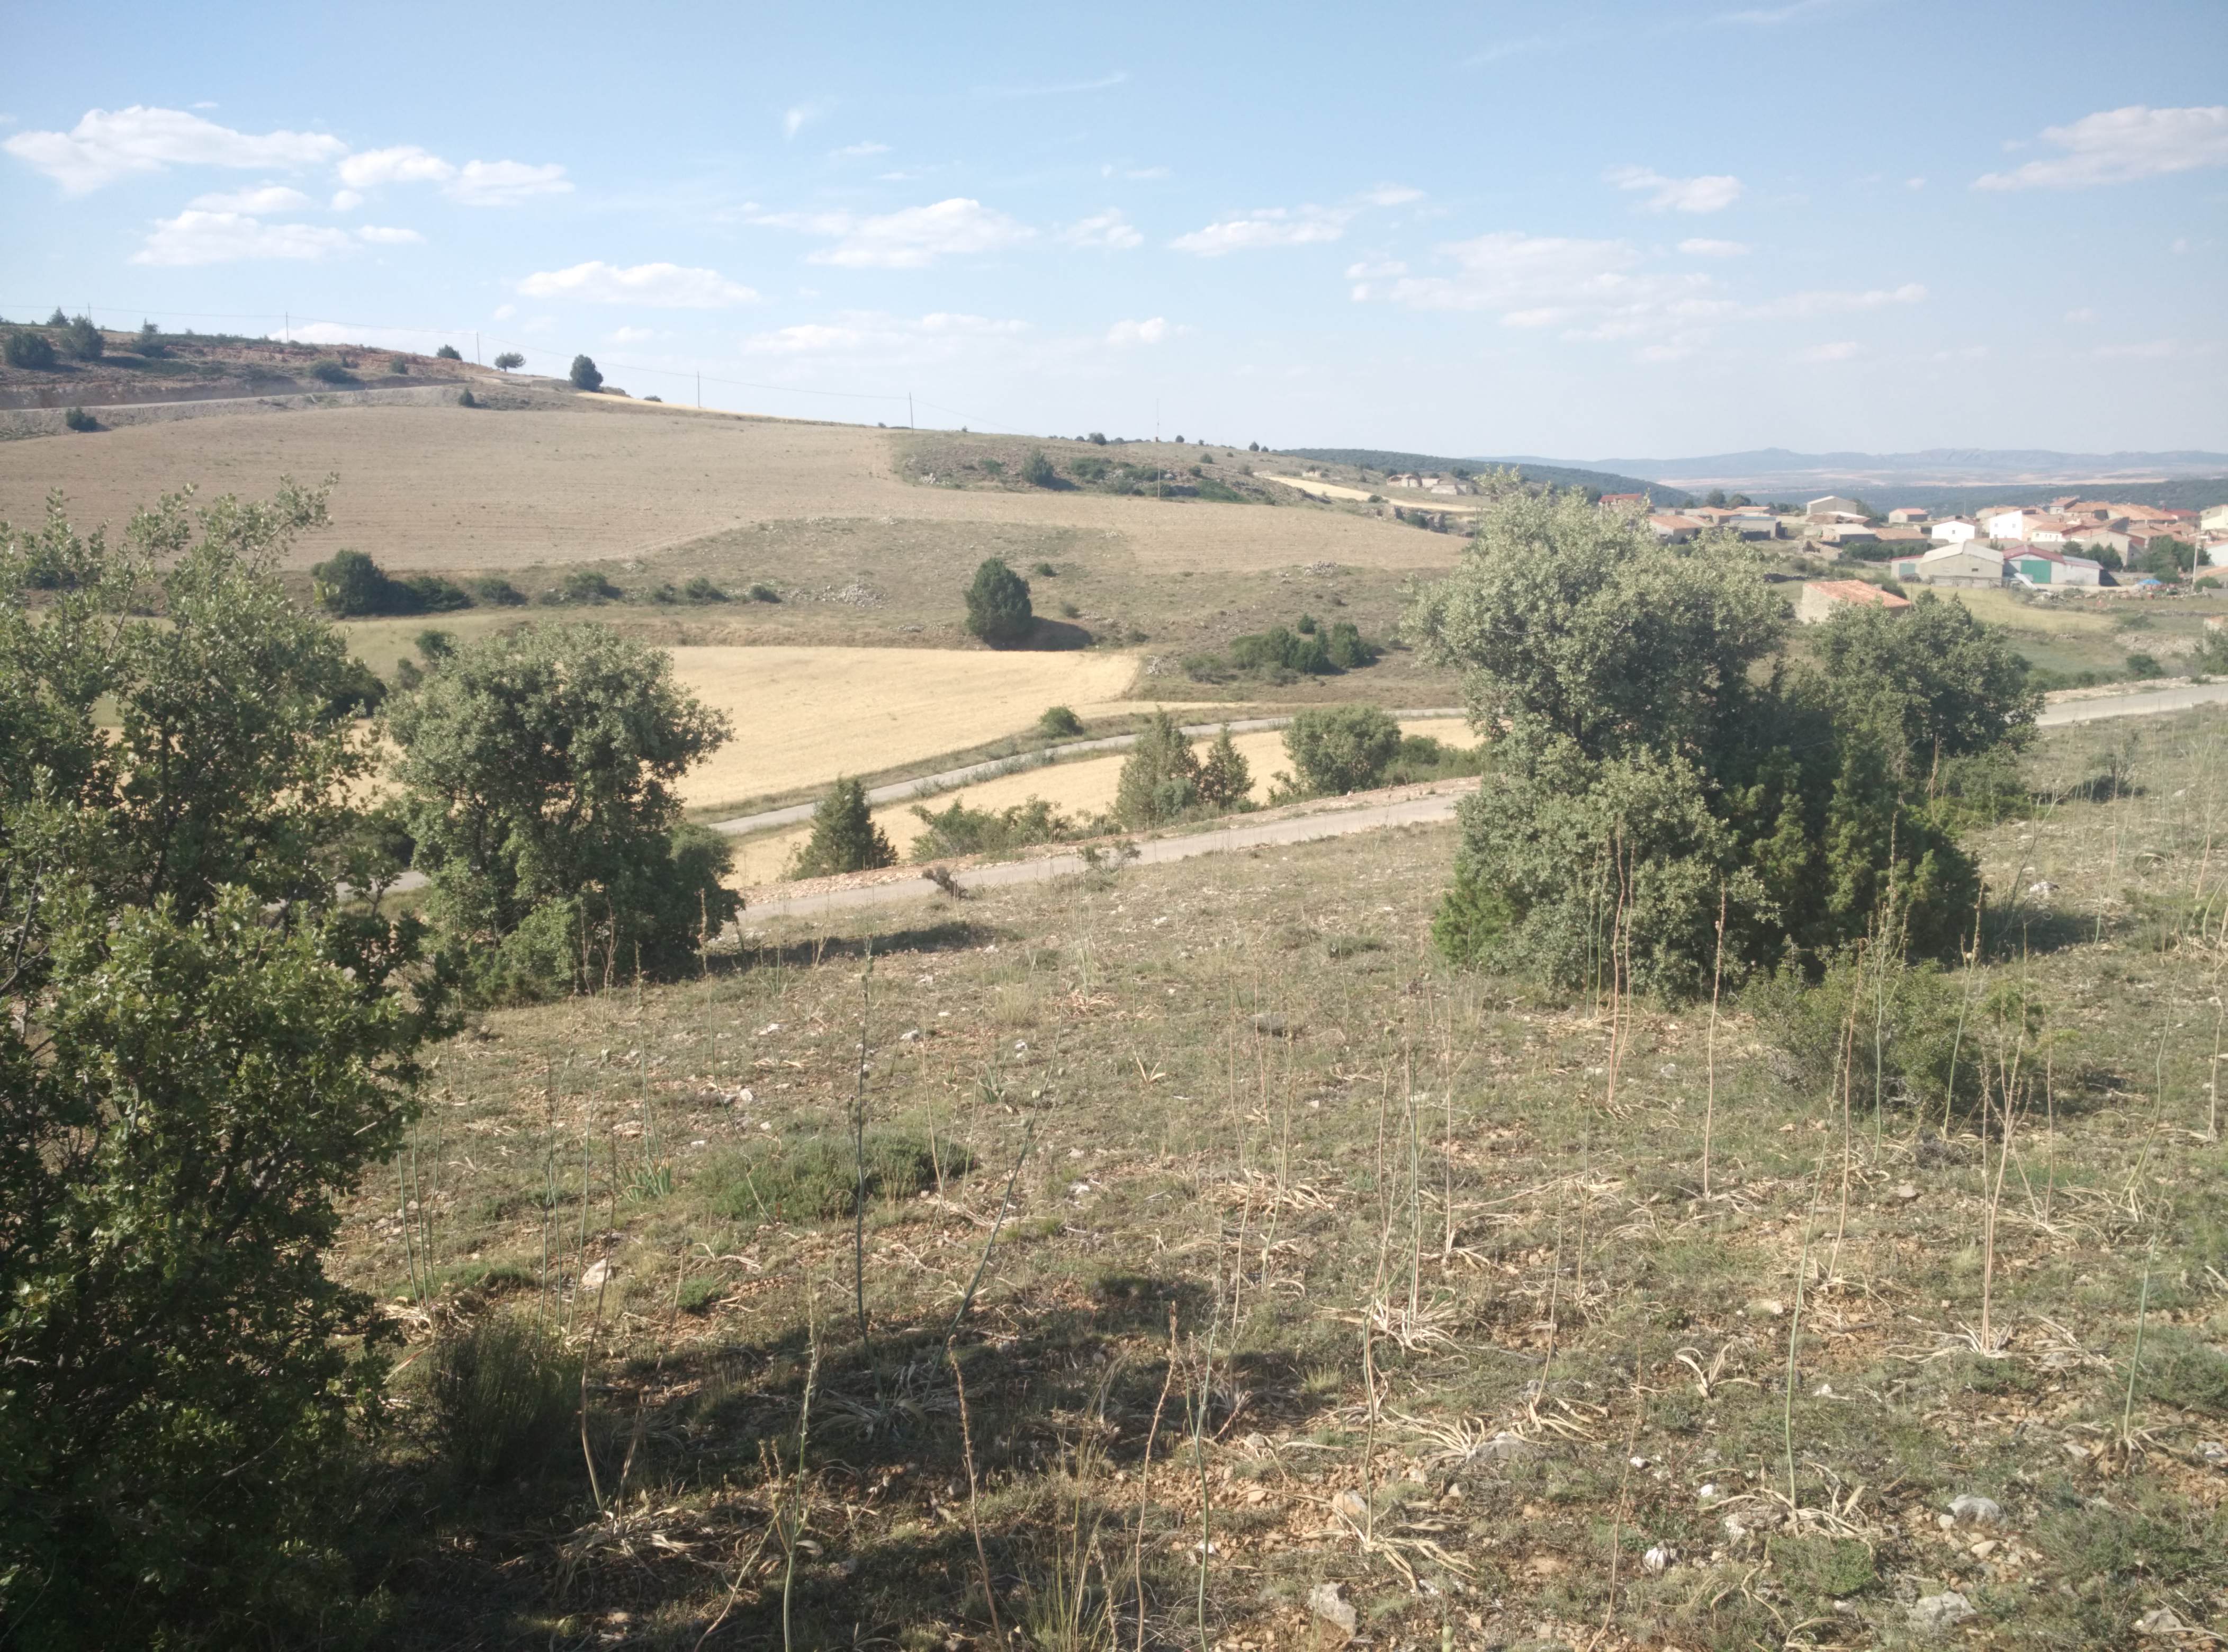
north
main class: Shrubland
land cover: Shrubland with sparse tree cover
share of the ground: 25 - 50 %
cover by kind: herbaceous plants 55 %, shrubs 25 %, unconsolidated bare surface 15 %, coniferous forest trees 5 %
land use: Semi-natural and natural areas not in use
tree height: < 5 m
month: June
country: ES
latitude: 40.6649
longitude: -1.8129
